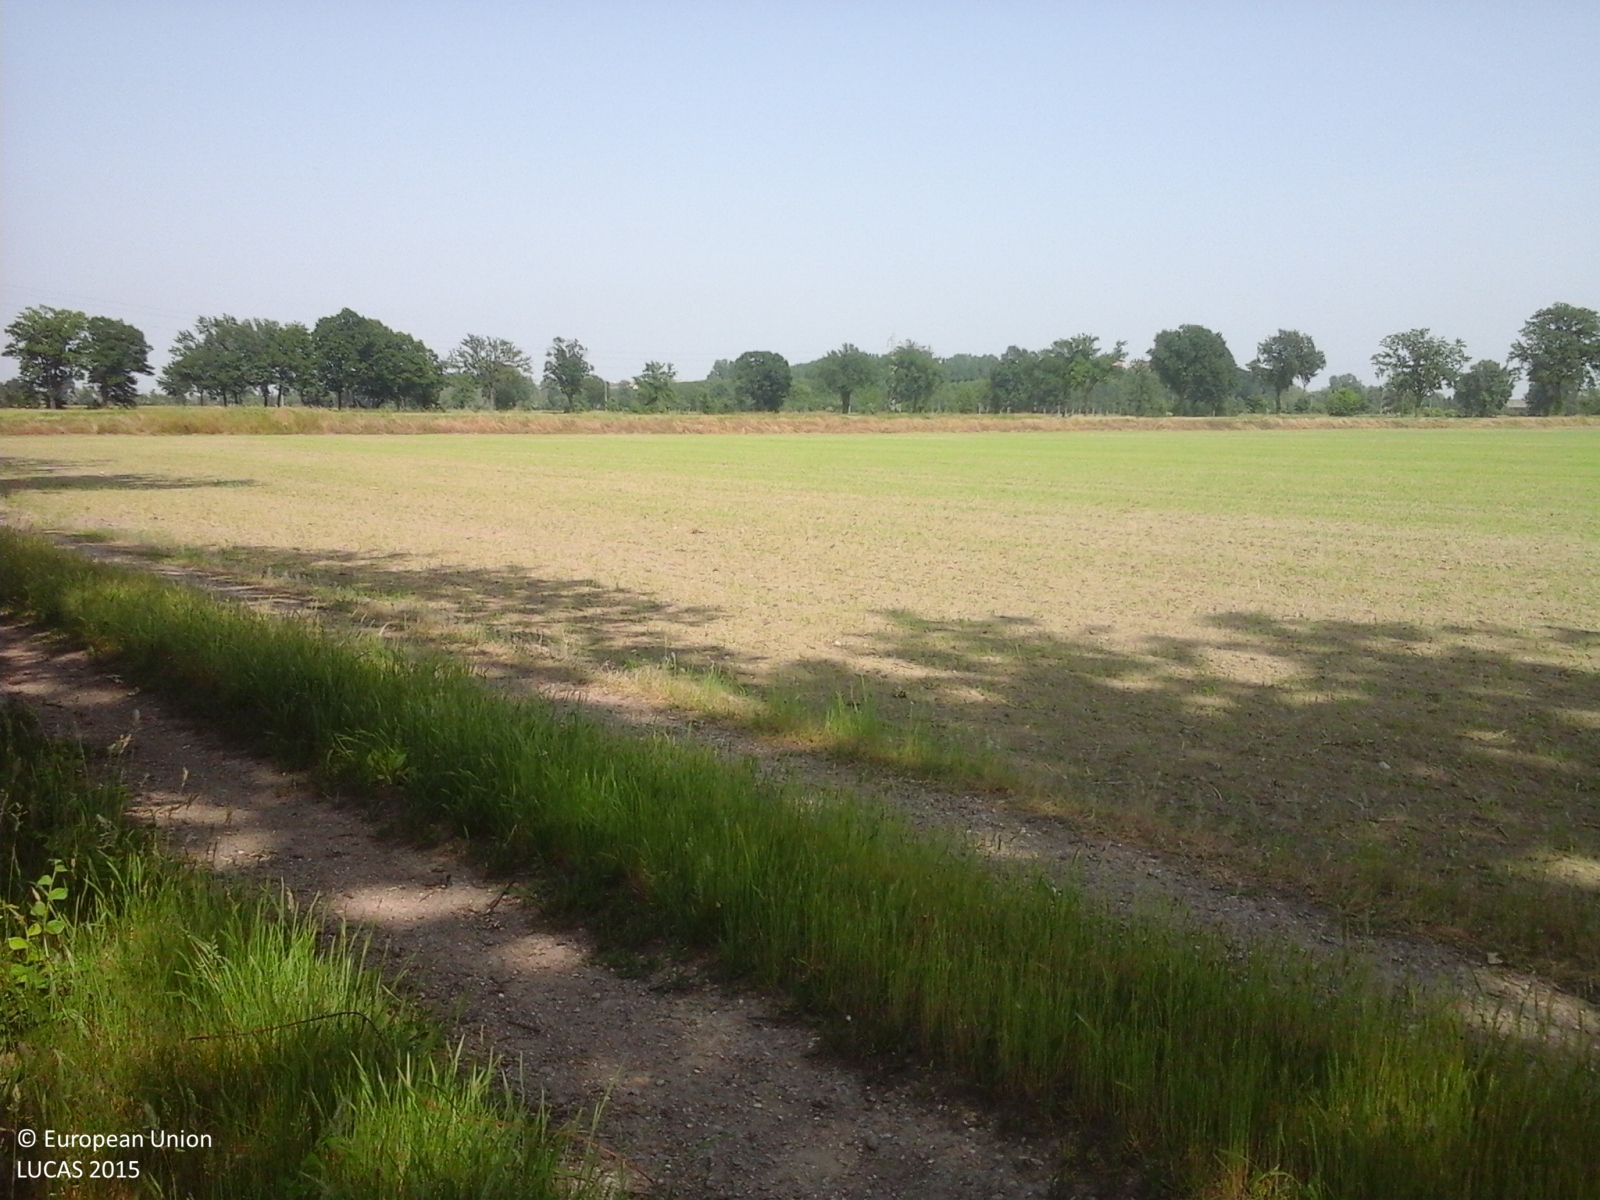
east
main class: Cropland
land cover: Rice
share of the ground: > 75 %
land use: Agriculture (excluding fallow land and kitchen gardens)
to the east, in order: Rice; Managed hedges; Ditches and canals; Managed hedges; Tracks; Grass margins; Rice; Grass margins; Tracks; Grass margins; Ditches and canals; Grass margins; Rice
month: May
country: IT
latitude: 45.3389
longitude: 9.1720
